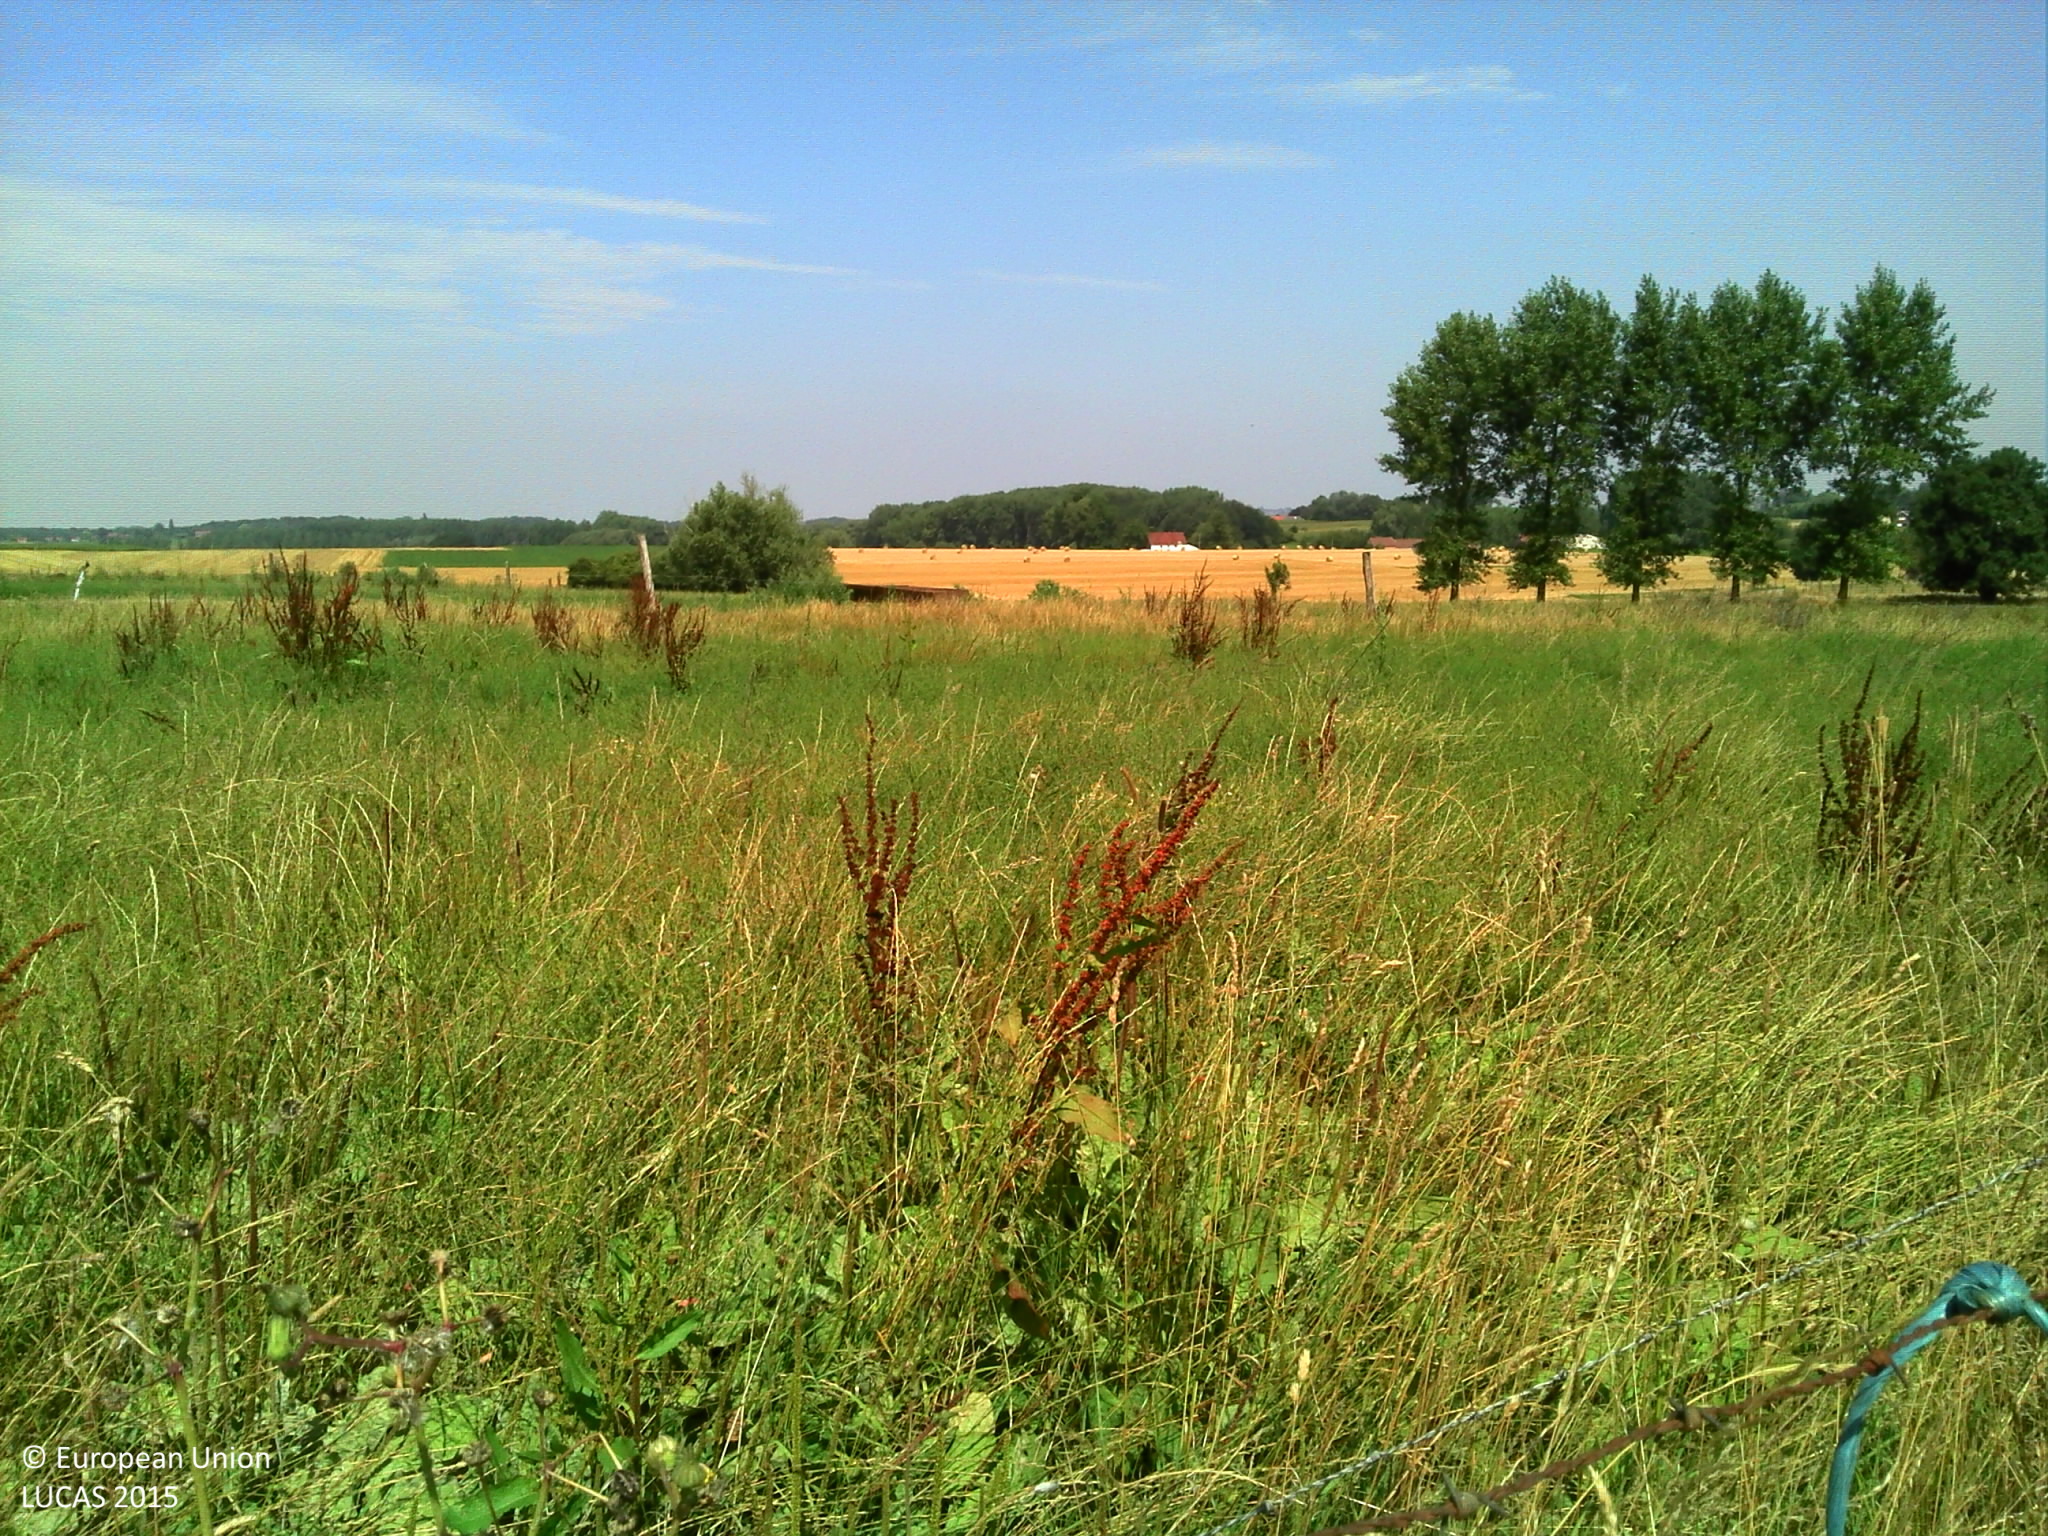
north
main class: Grassland
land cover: Grassland without tree/shrub cover
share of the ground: > 75 %
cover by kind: herbaceous plants 100 %
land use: Agriculture (excluding fallow land and kitchen gardens)
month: August
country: BE
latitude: 50.6893
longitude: 3.9213
